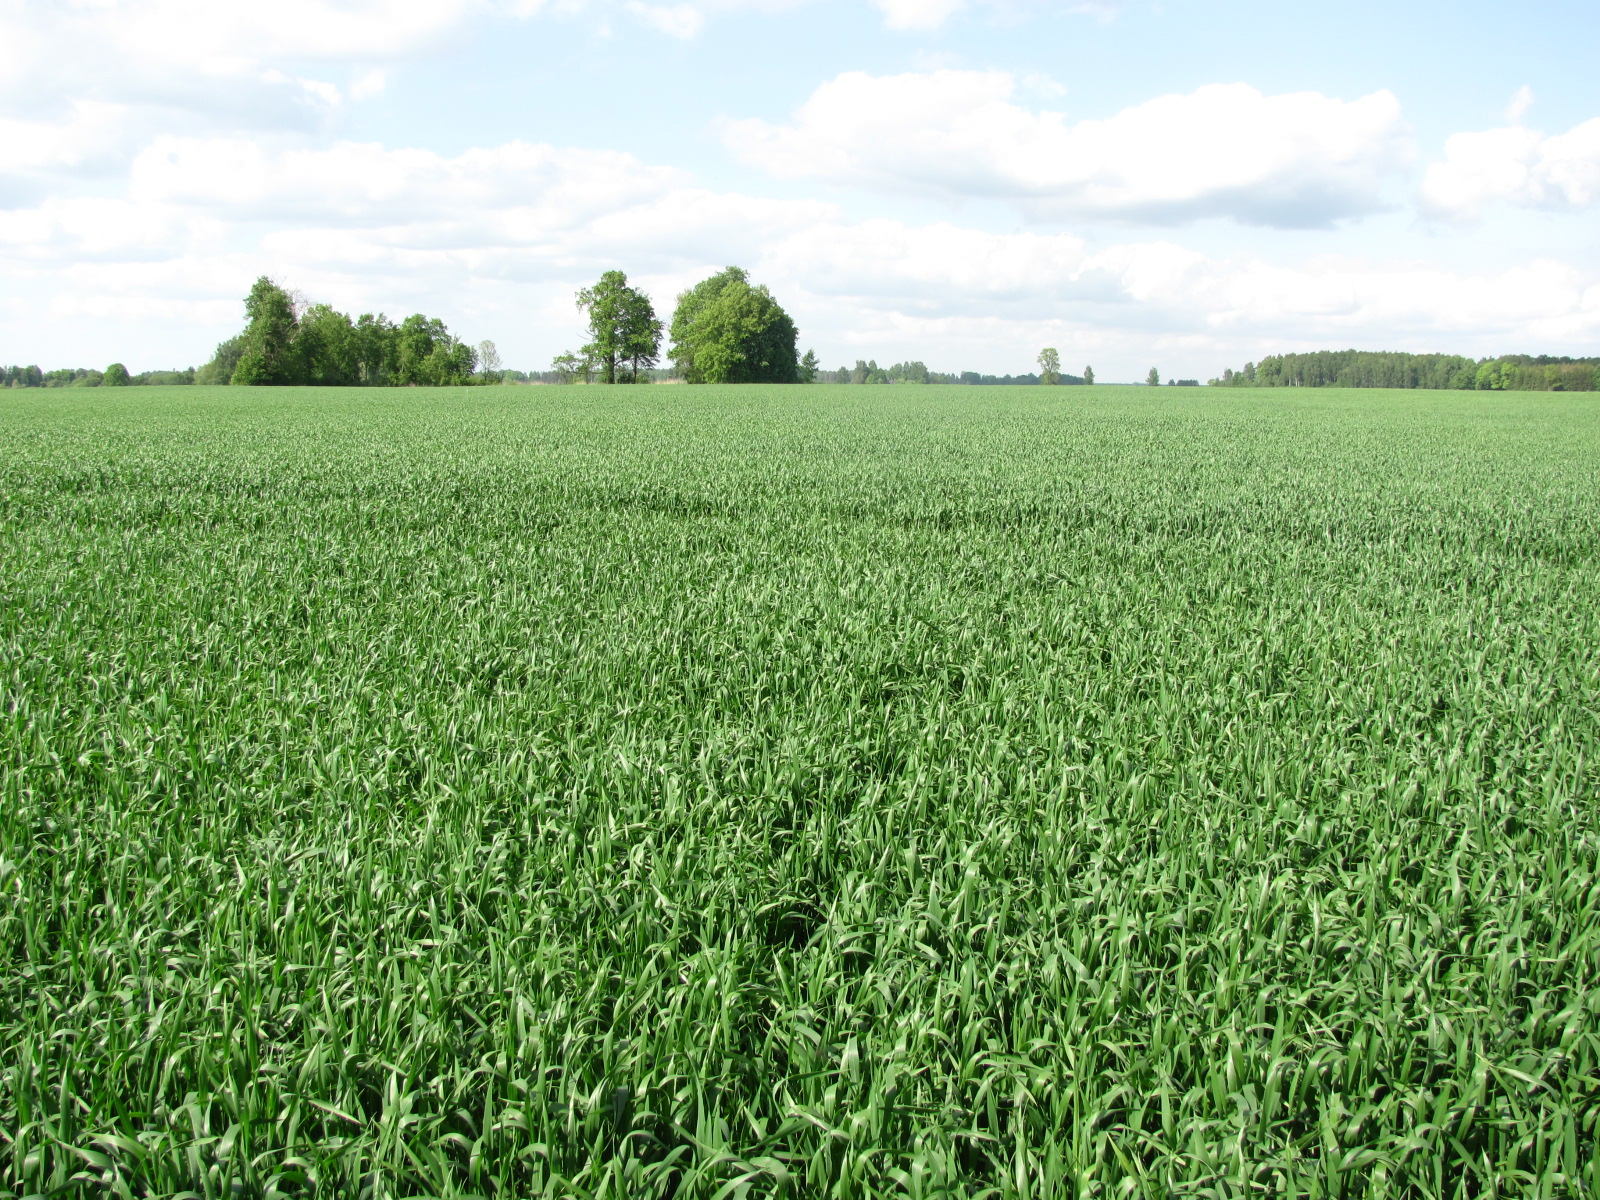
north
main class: Cropland
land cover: Common wheat
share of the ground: > 75 %
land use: Agriculture (excluding fallow land and kitchen gardens)
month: May
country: LV
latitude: 56.5774
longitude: 23.9033
